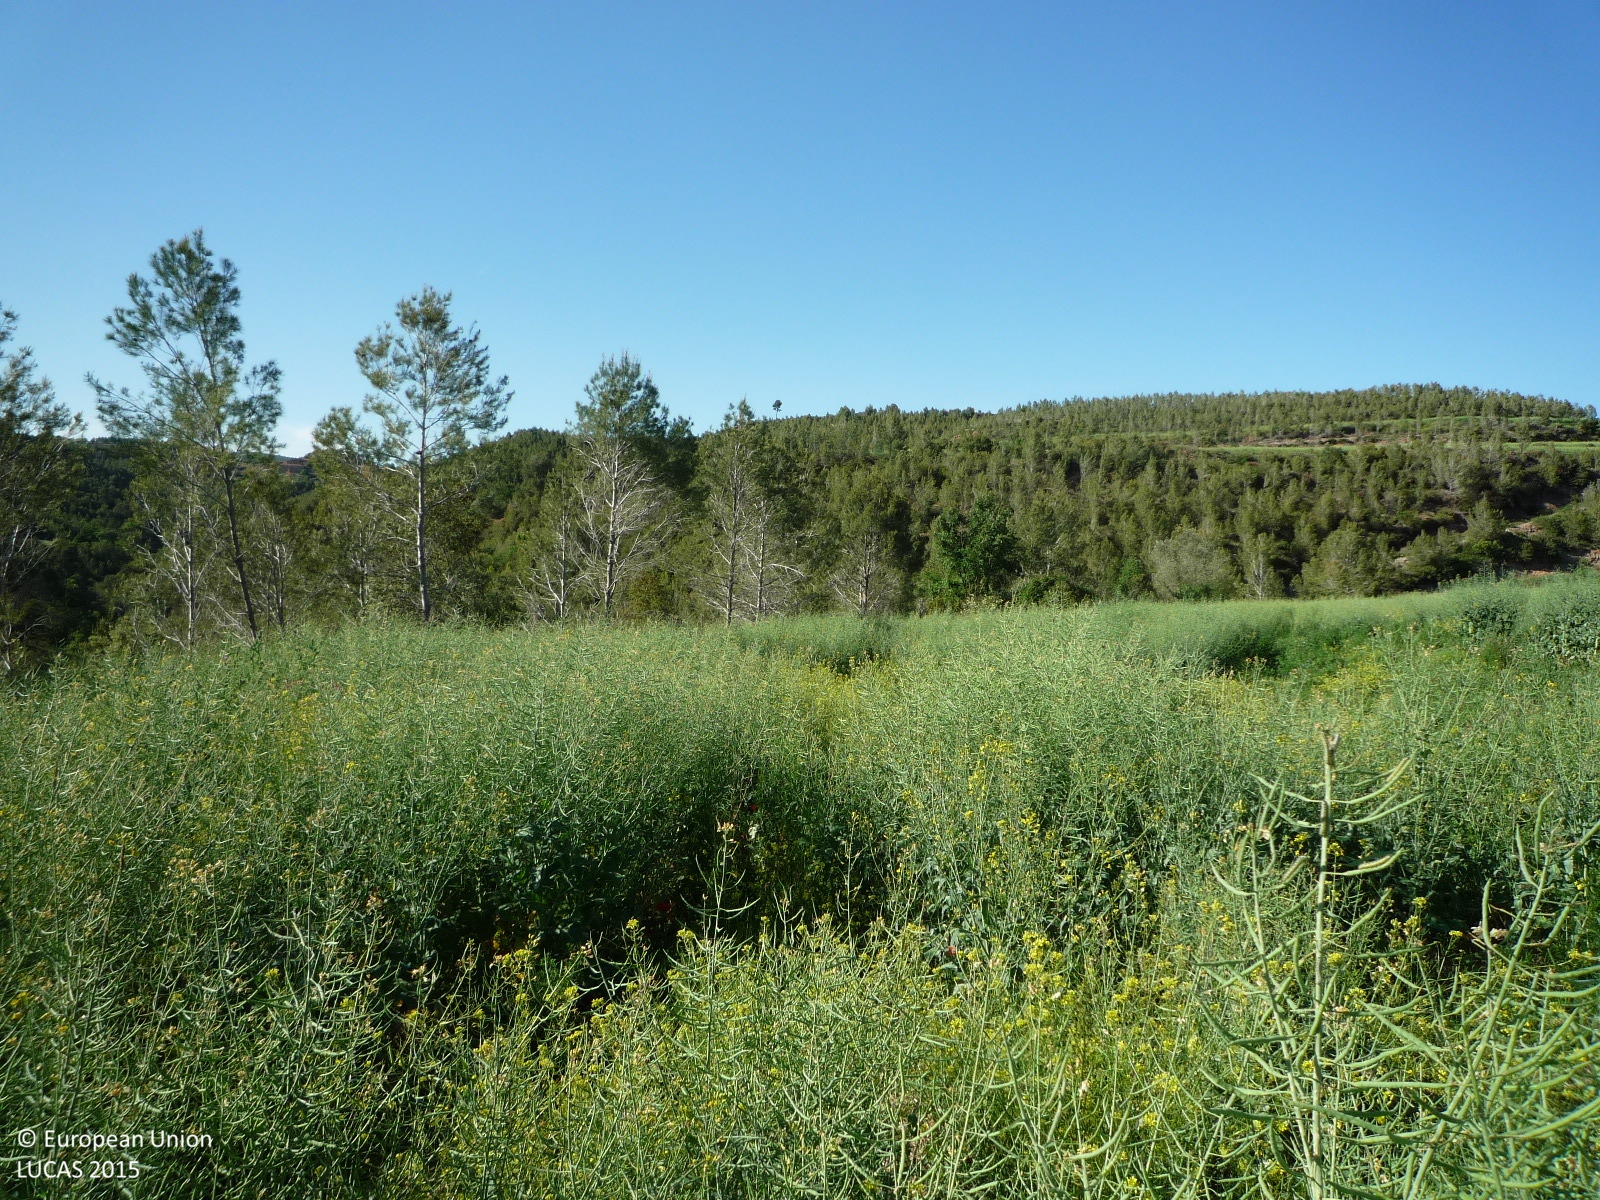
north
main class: Cropland
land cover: Rape and turnip rape
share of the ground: > 75 %
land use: Agriculture (excluding fallow land and kitchen gardens)
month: May
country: ES
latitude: 41.7905
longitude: 1.7476
